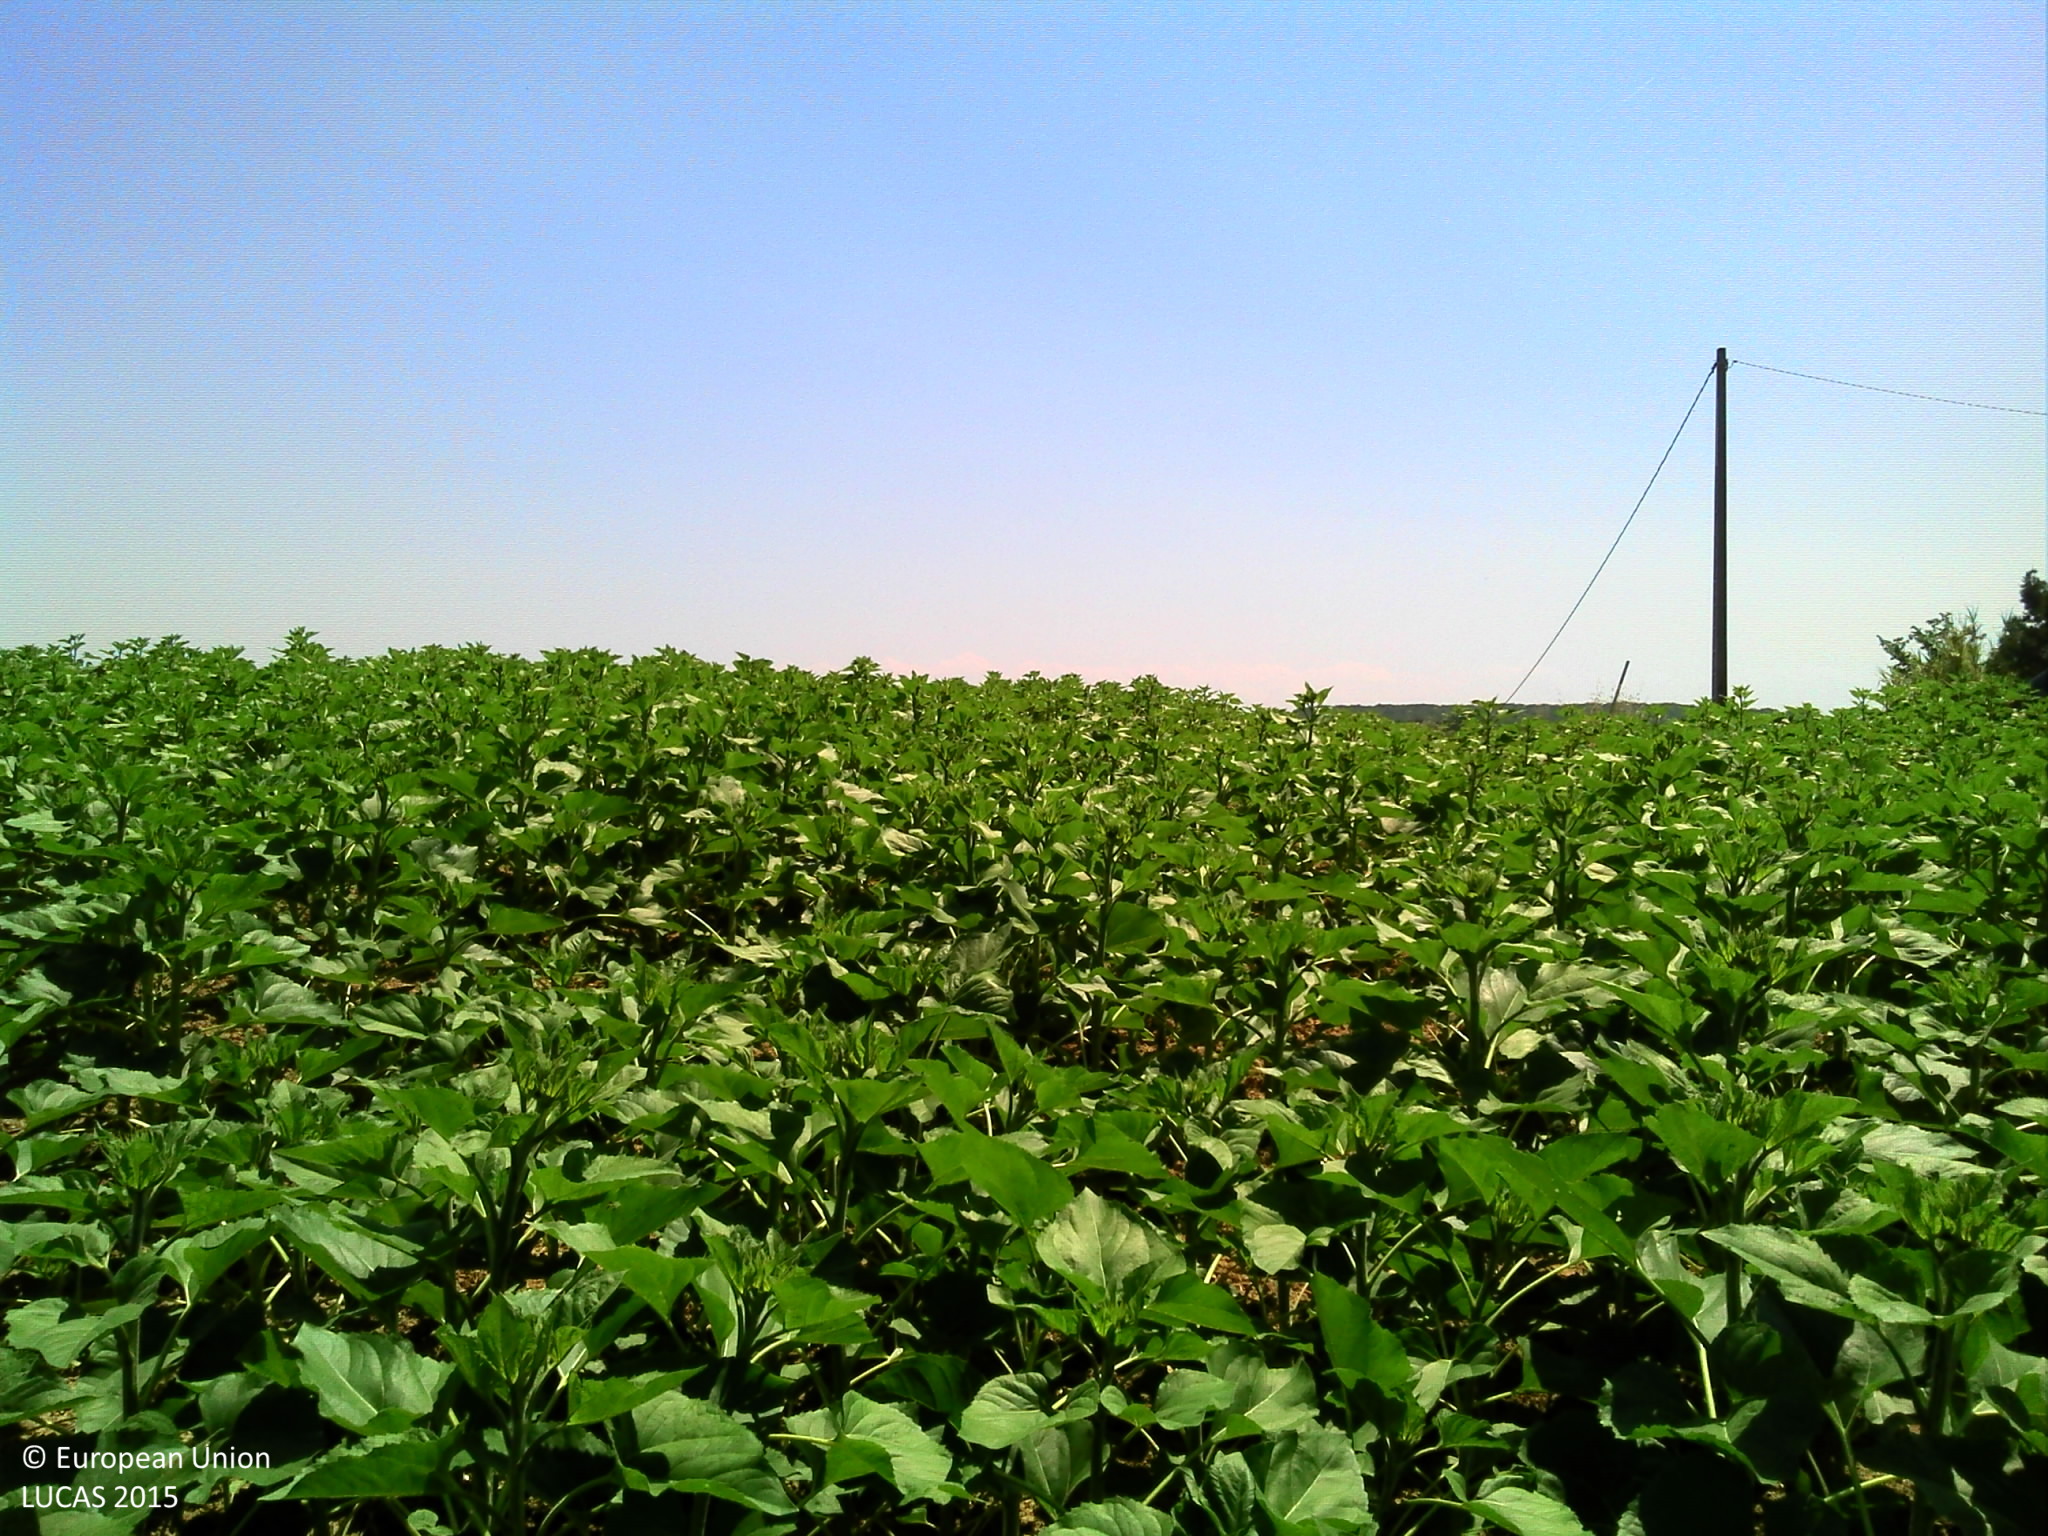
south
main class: Cropland
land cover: Sunflower
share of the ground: > 75 %
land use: Agriculture (excluding fallow land and kitchen gardens)
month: June
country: FR
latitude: 43.7251
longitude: 1.0247
